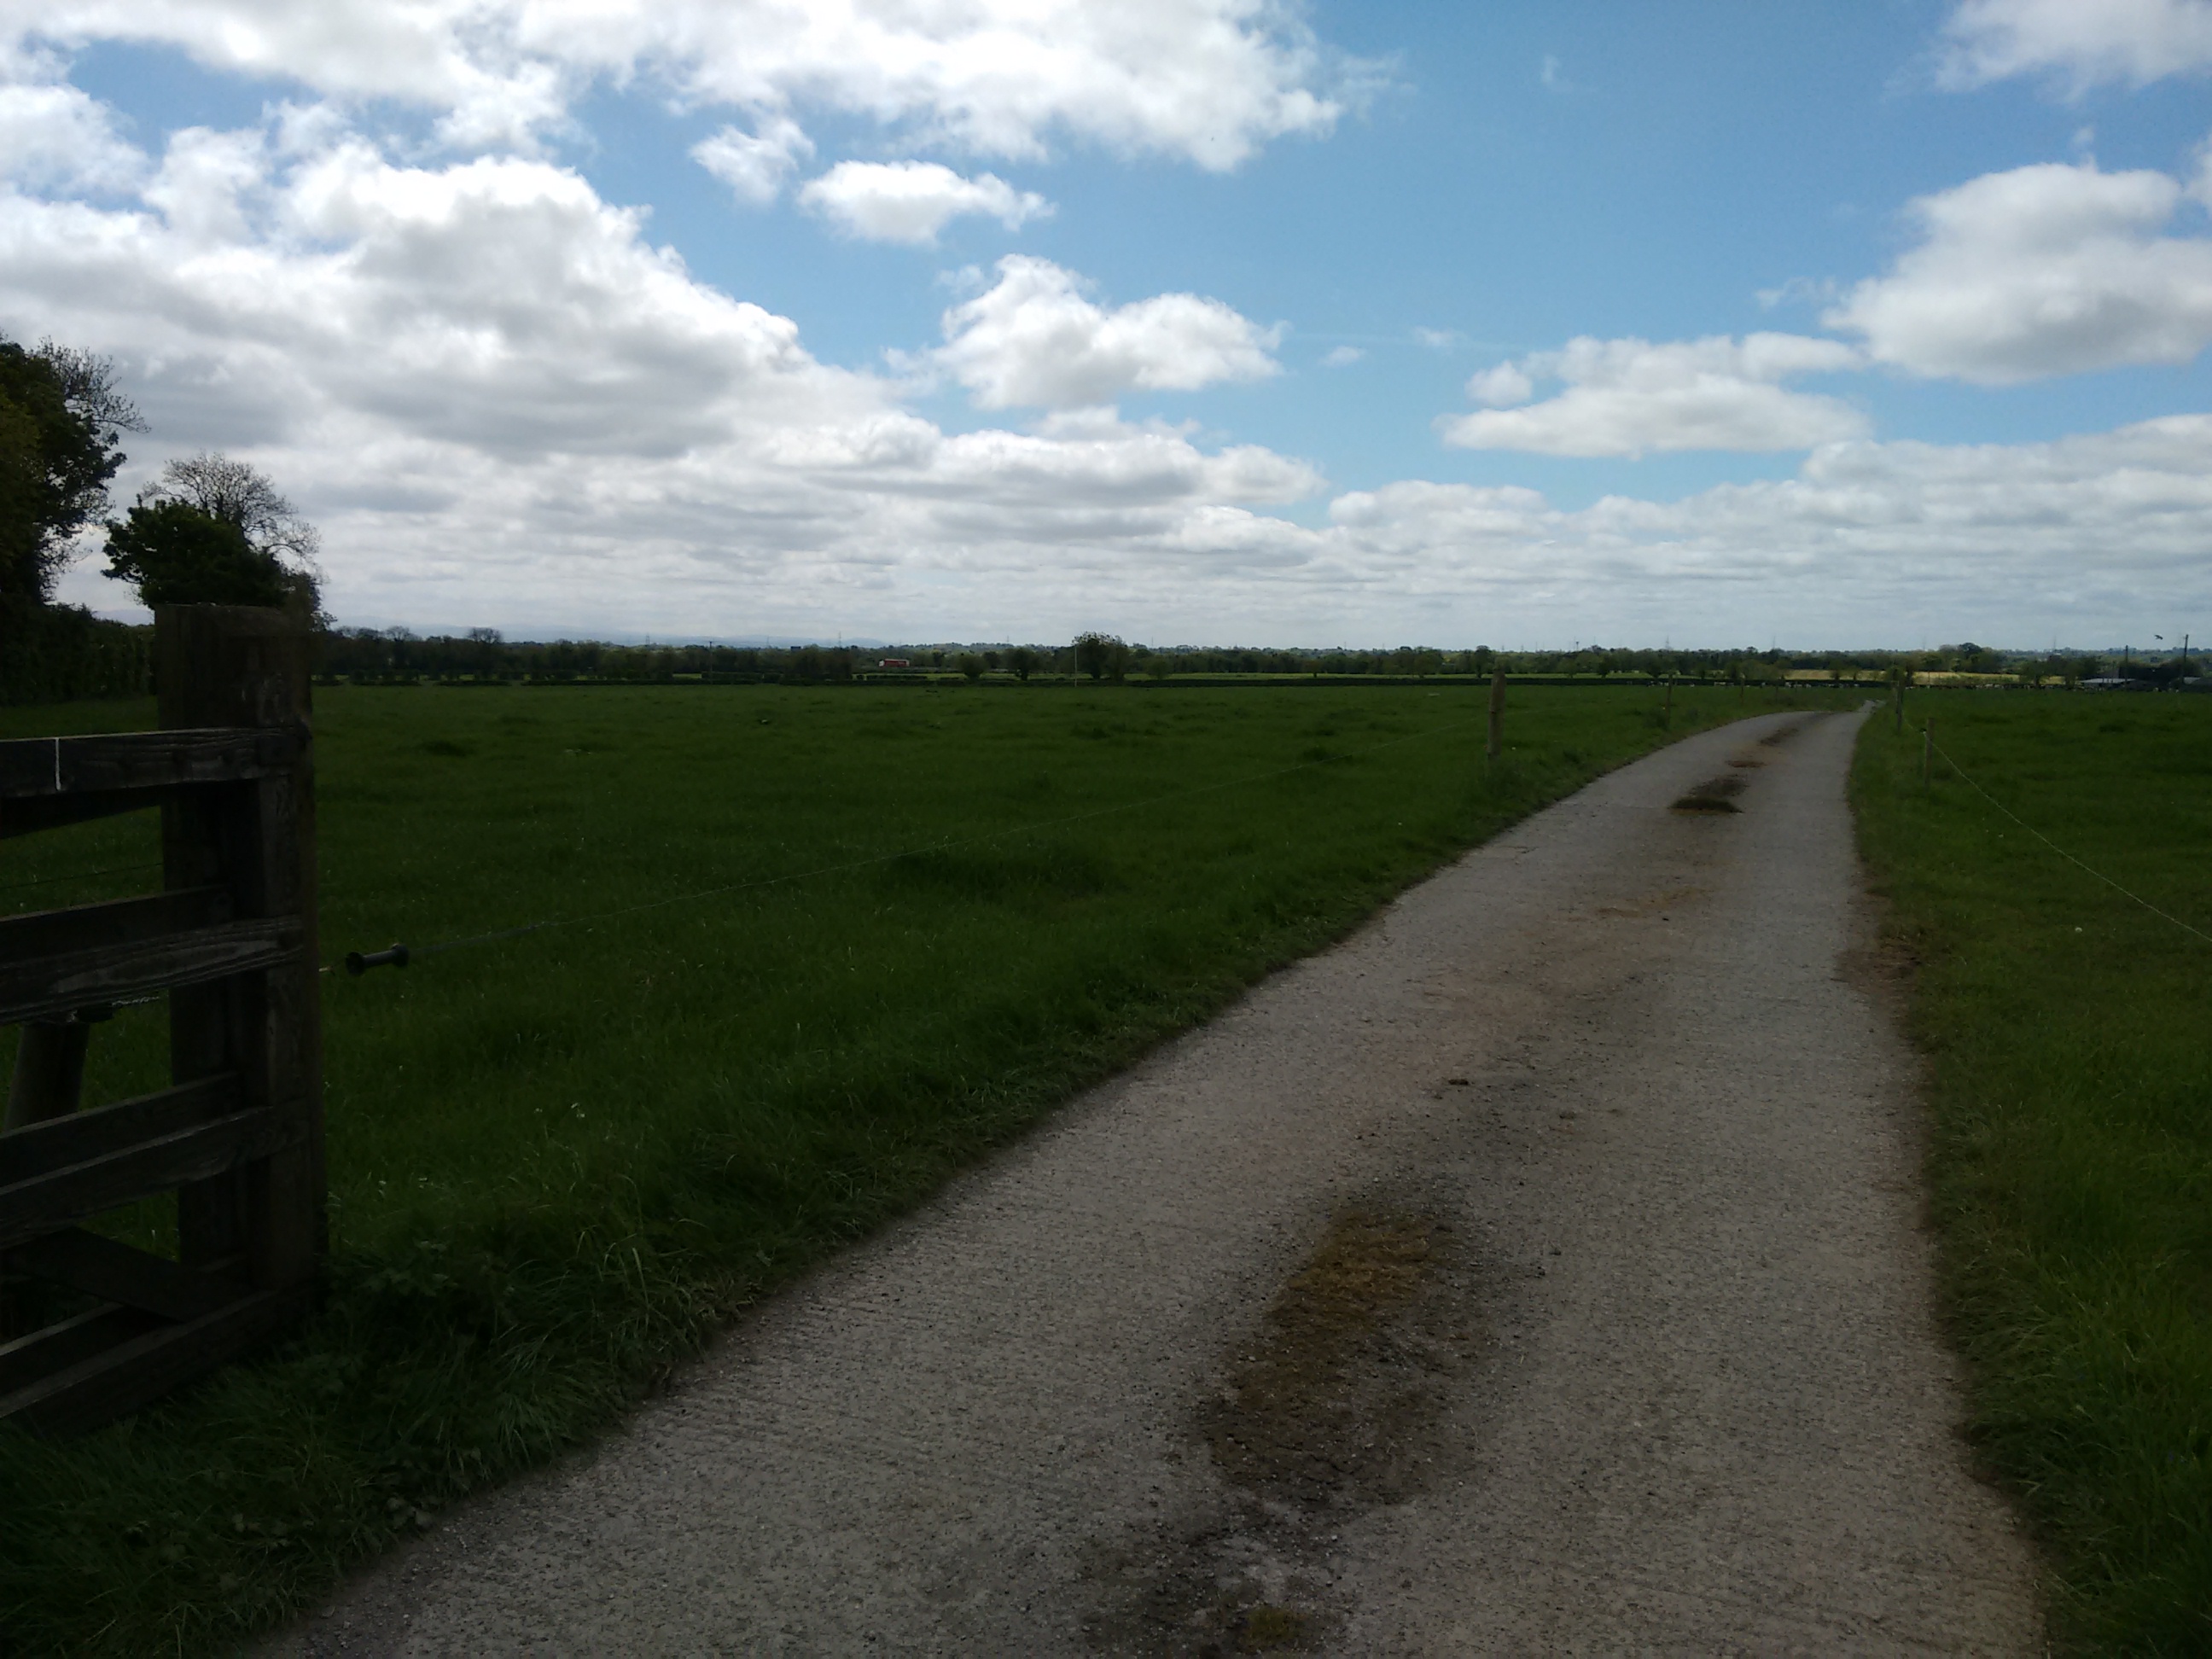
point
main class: Grassland
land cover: Grassland without tree/shrub cover
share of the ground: > 75 %
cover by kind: herbaceous plants 100 %
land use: Agriculture (excluding fallow land and kitchen gardens)
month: May
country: IE
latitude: 53.5019
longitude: -6.5459
